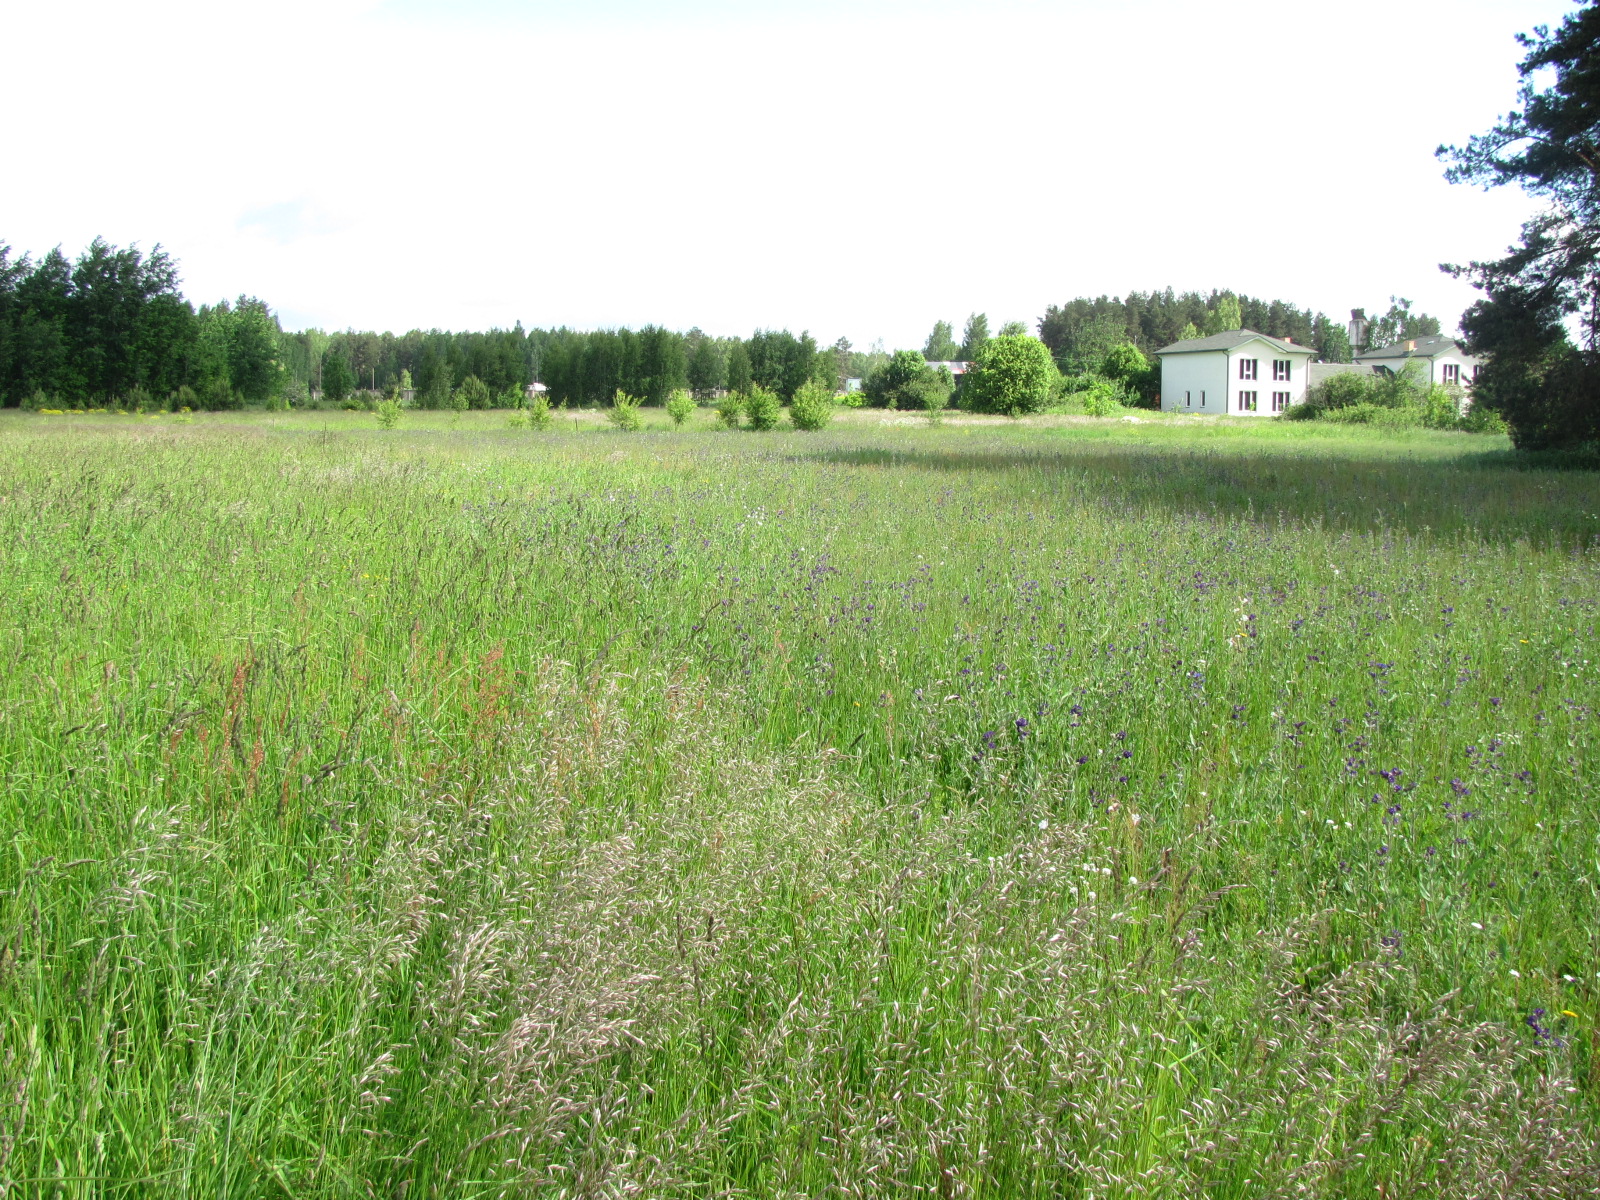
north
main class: Grassland
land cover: Grassland without tree/shrub cover
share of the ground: > 75 %
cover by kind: herbaceous plants 100 %
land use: Residential
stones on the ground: < 10 %
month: June
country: LV
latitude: 56.8193
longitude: 24.5289
